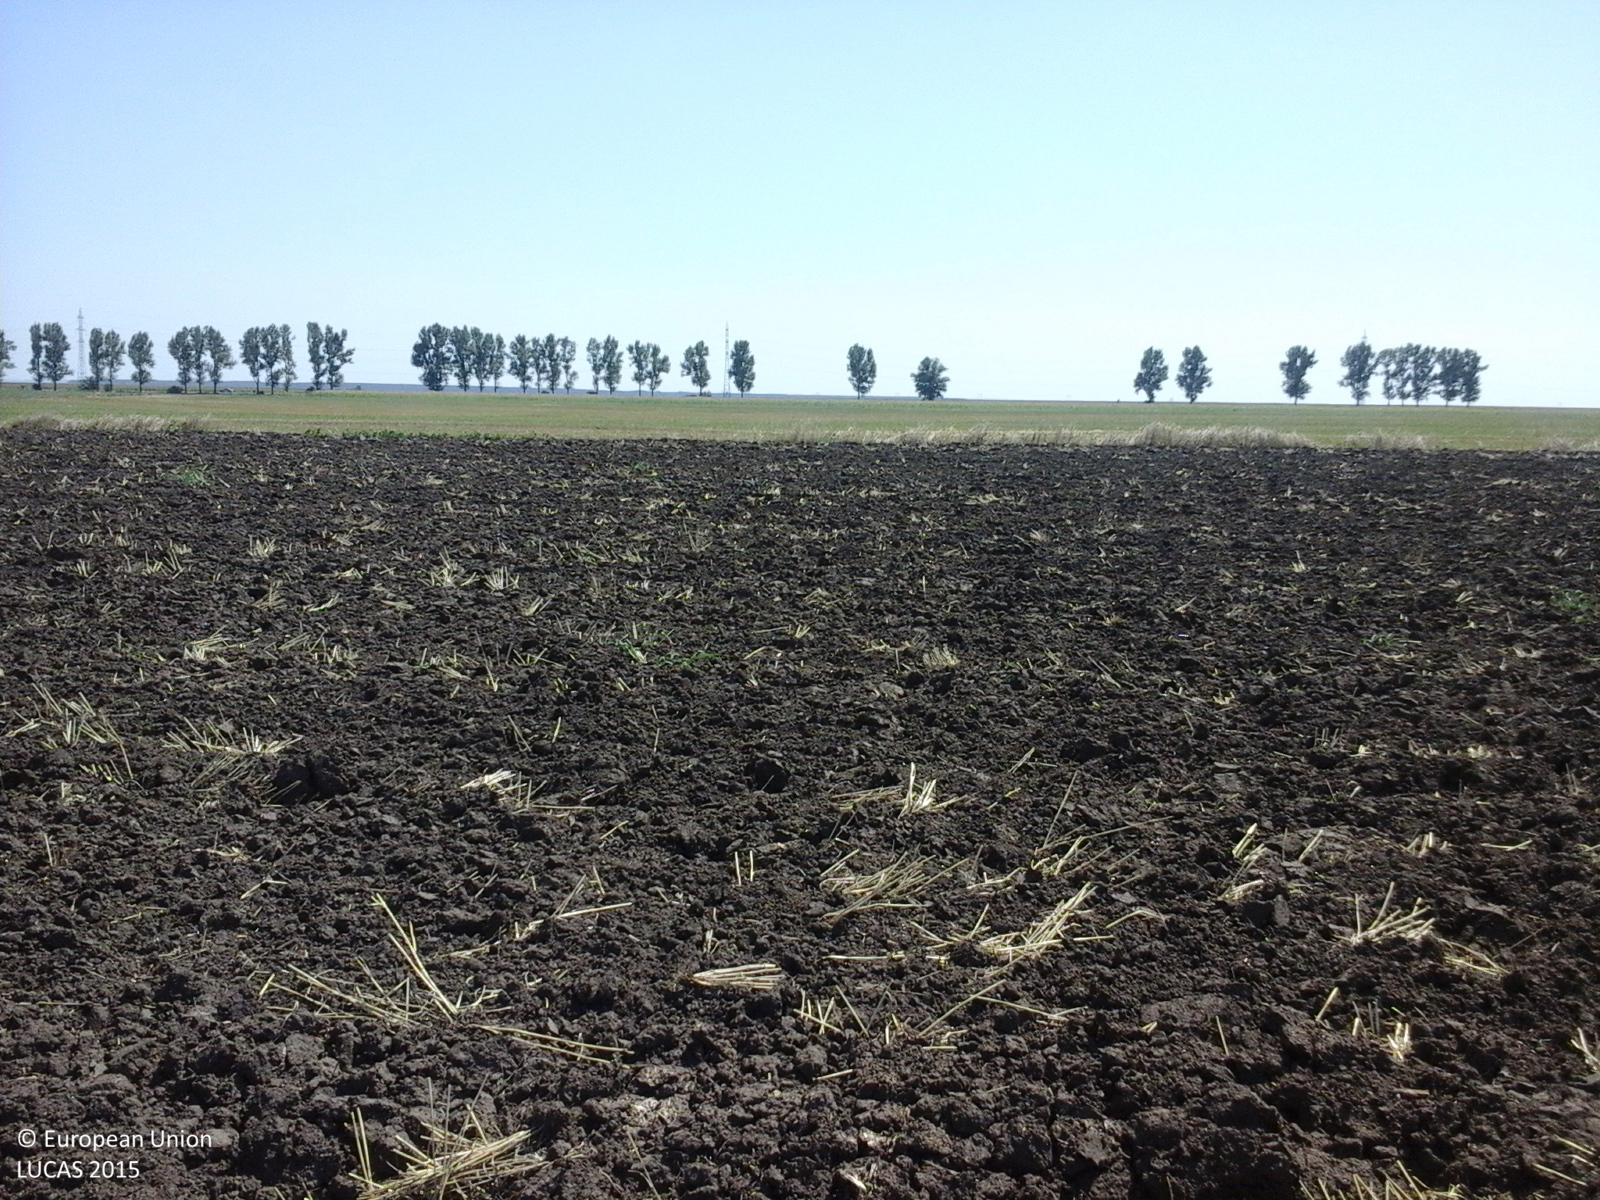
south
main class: Cropland
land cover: Common wheat
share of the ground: < 10 %
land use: Agriculture (excluding fallow land and kitchen gardens)
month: July
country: RO
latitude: 44.2467
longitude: 26.6341
